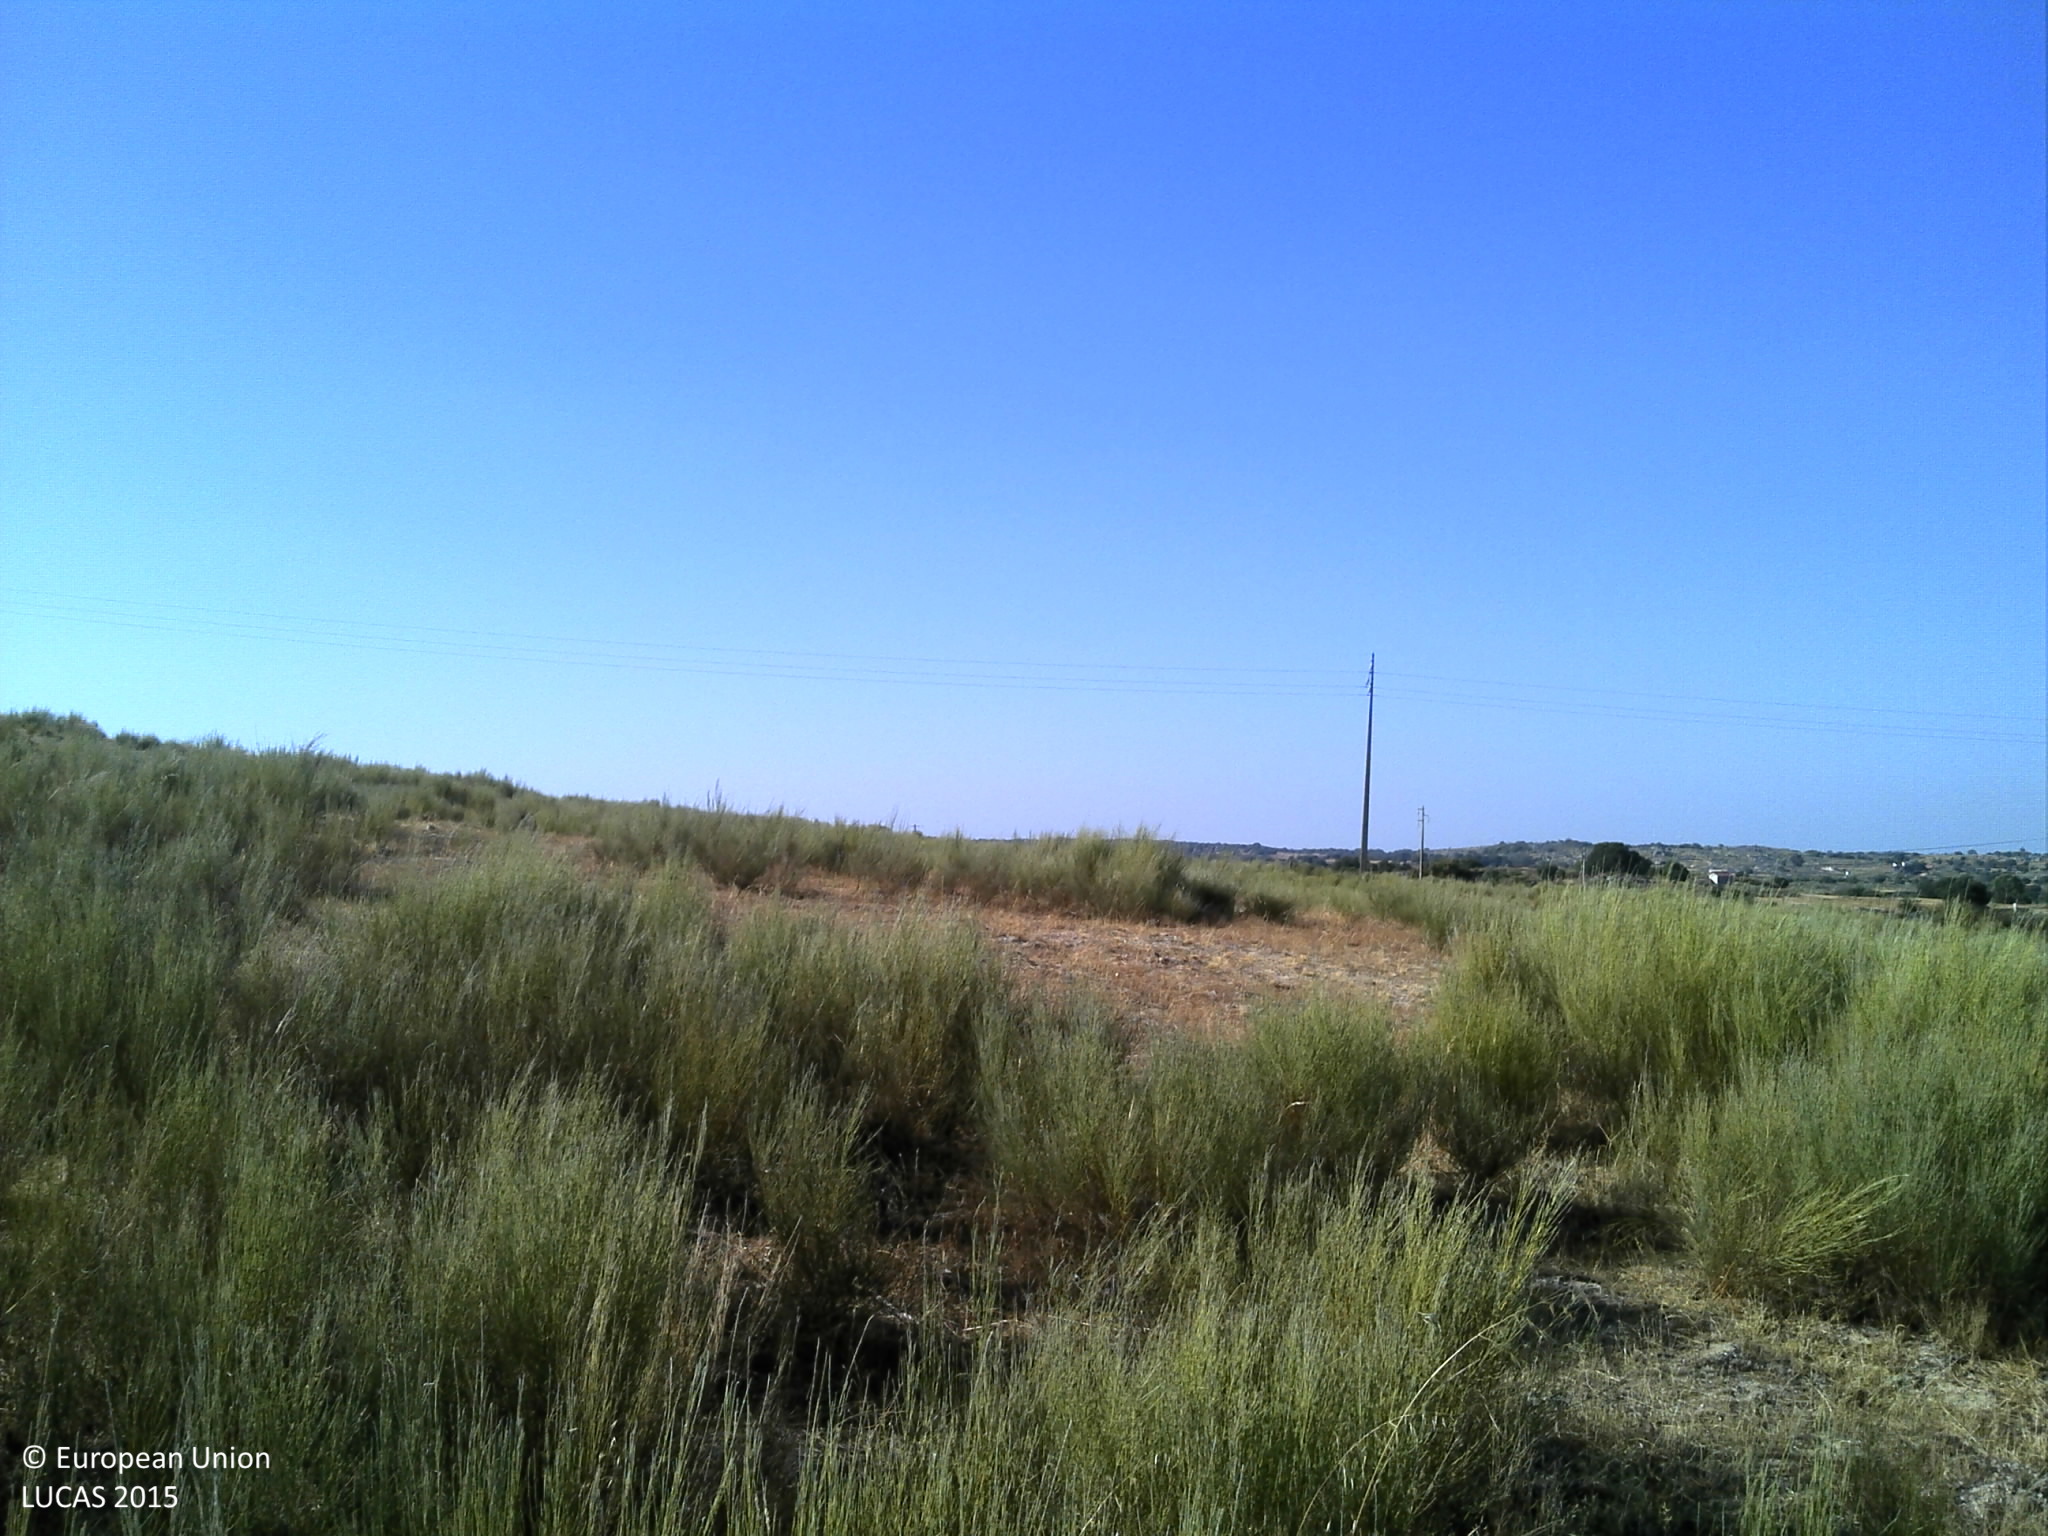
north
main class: Shrubland
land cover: Shrubland without tree cover
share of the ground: 25 - 50 %
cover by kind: unconsolidated bare surface 50 %, shrubs 30 %, herbaceous plants 20 %
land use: Agriculture (excluding fallow land and kitchen gardens)
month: August
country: PT
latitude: 39.4360
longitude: -7.5082
